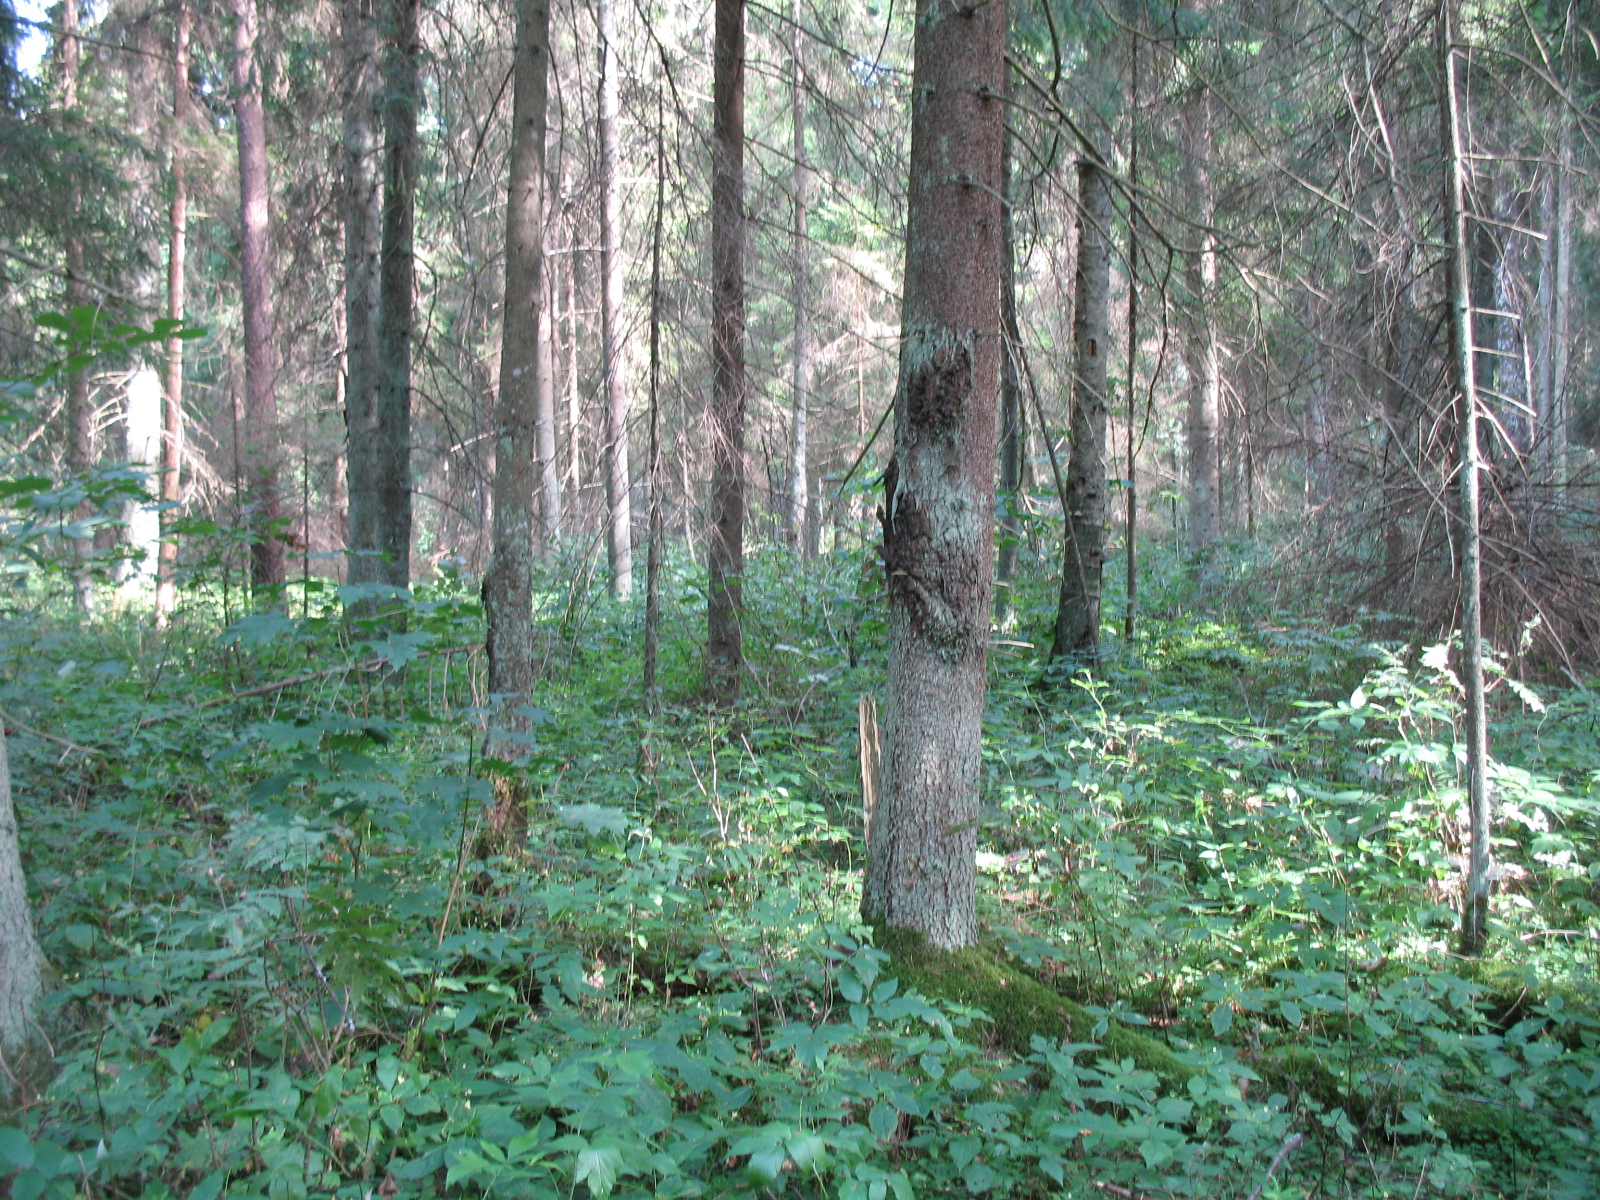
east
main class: Woodland
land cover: Other coniferous woodland
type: hemiboreal forest and nemoral coniferous forest and mixed broadleaved-coniferous forest
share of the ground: > 75 %
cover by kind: coniferous forest trees 75 %, broadleaved forest trees 10 %, herbaceous plants 10 %, shrubs 5 %
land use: Forestry
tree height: > 5 m
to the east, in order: Other coniferous woodland; Other mixed woodland; Broadleaved woodland
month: August
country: LV
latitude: 56.3478
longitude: 25.5752
